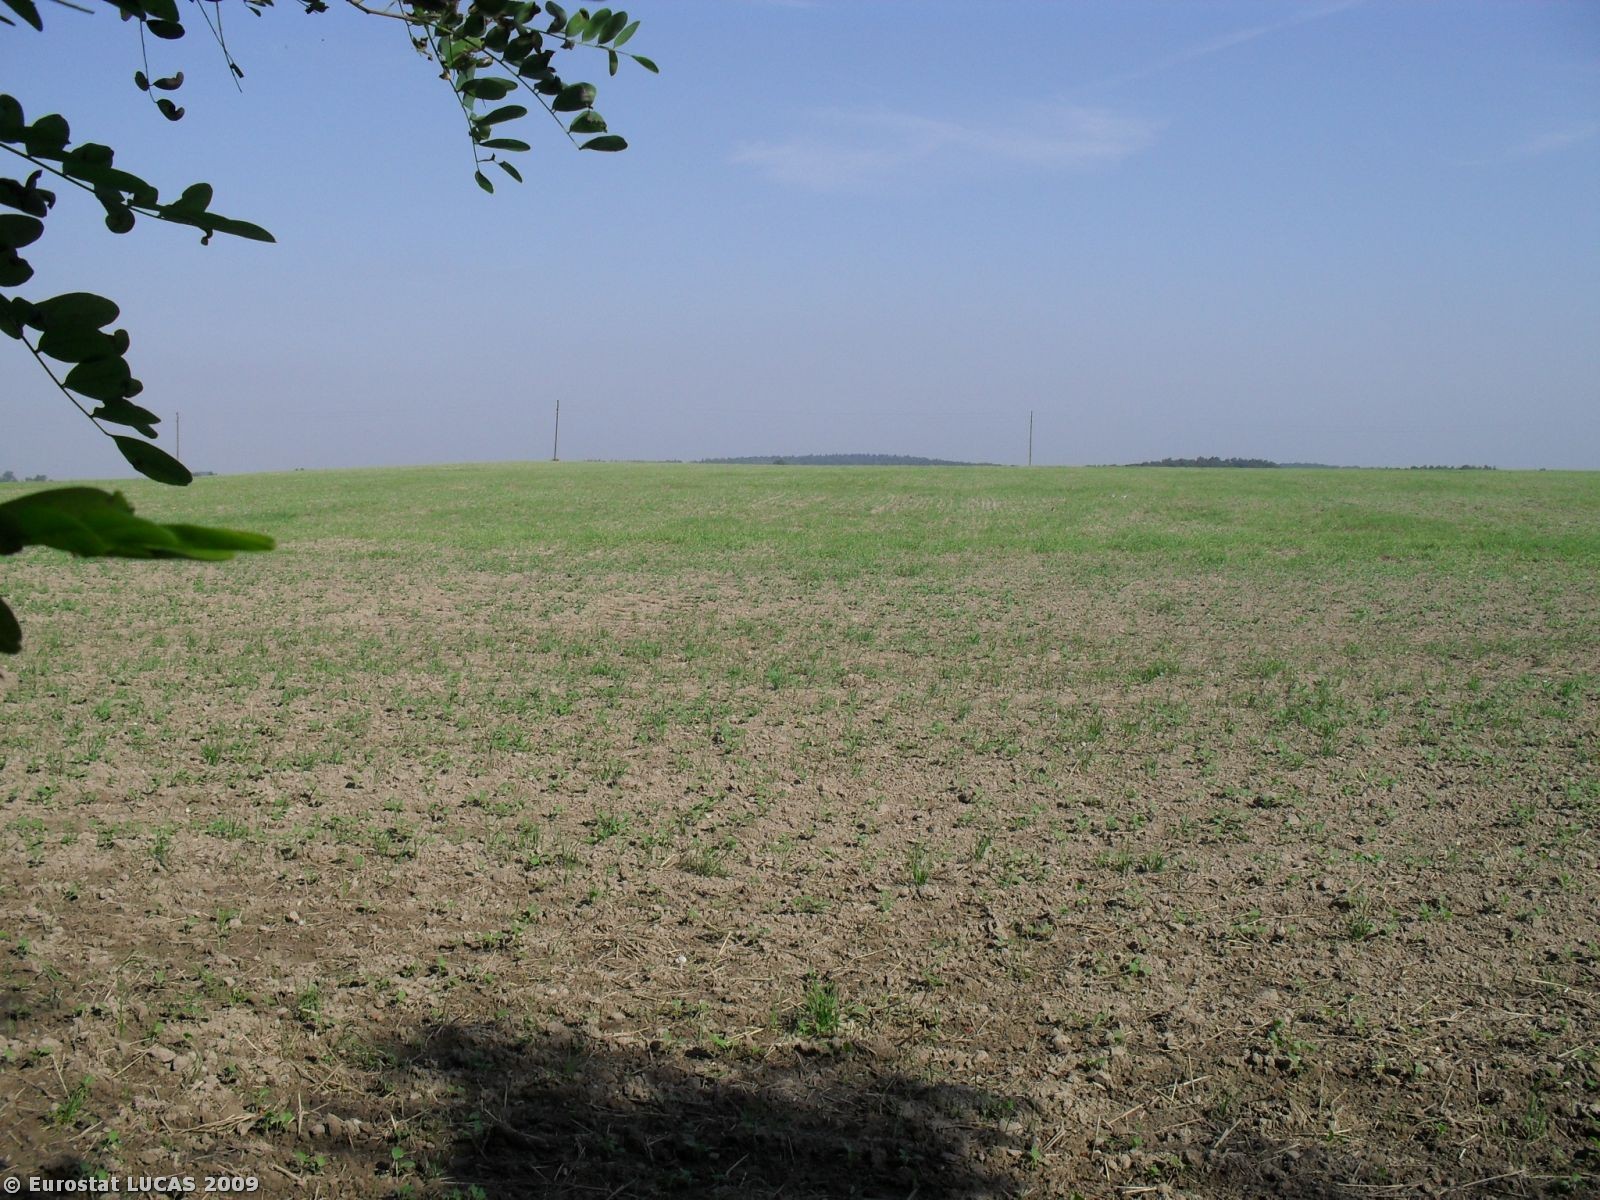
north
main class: Shrubland
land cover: Shrubland with sparse tree cover
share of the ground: > 75 %
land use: Unused
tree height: > 5 m
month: September
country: PL
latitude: 50.6384
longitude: 17.2651
